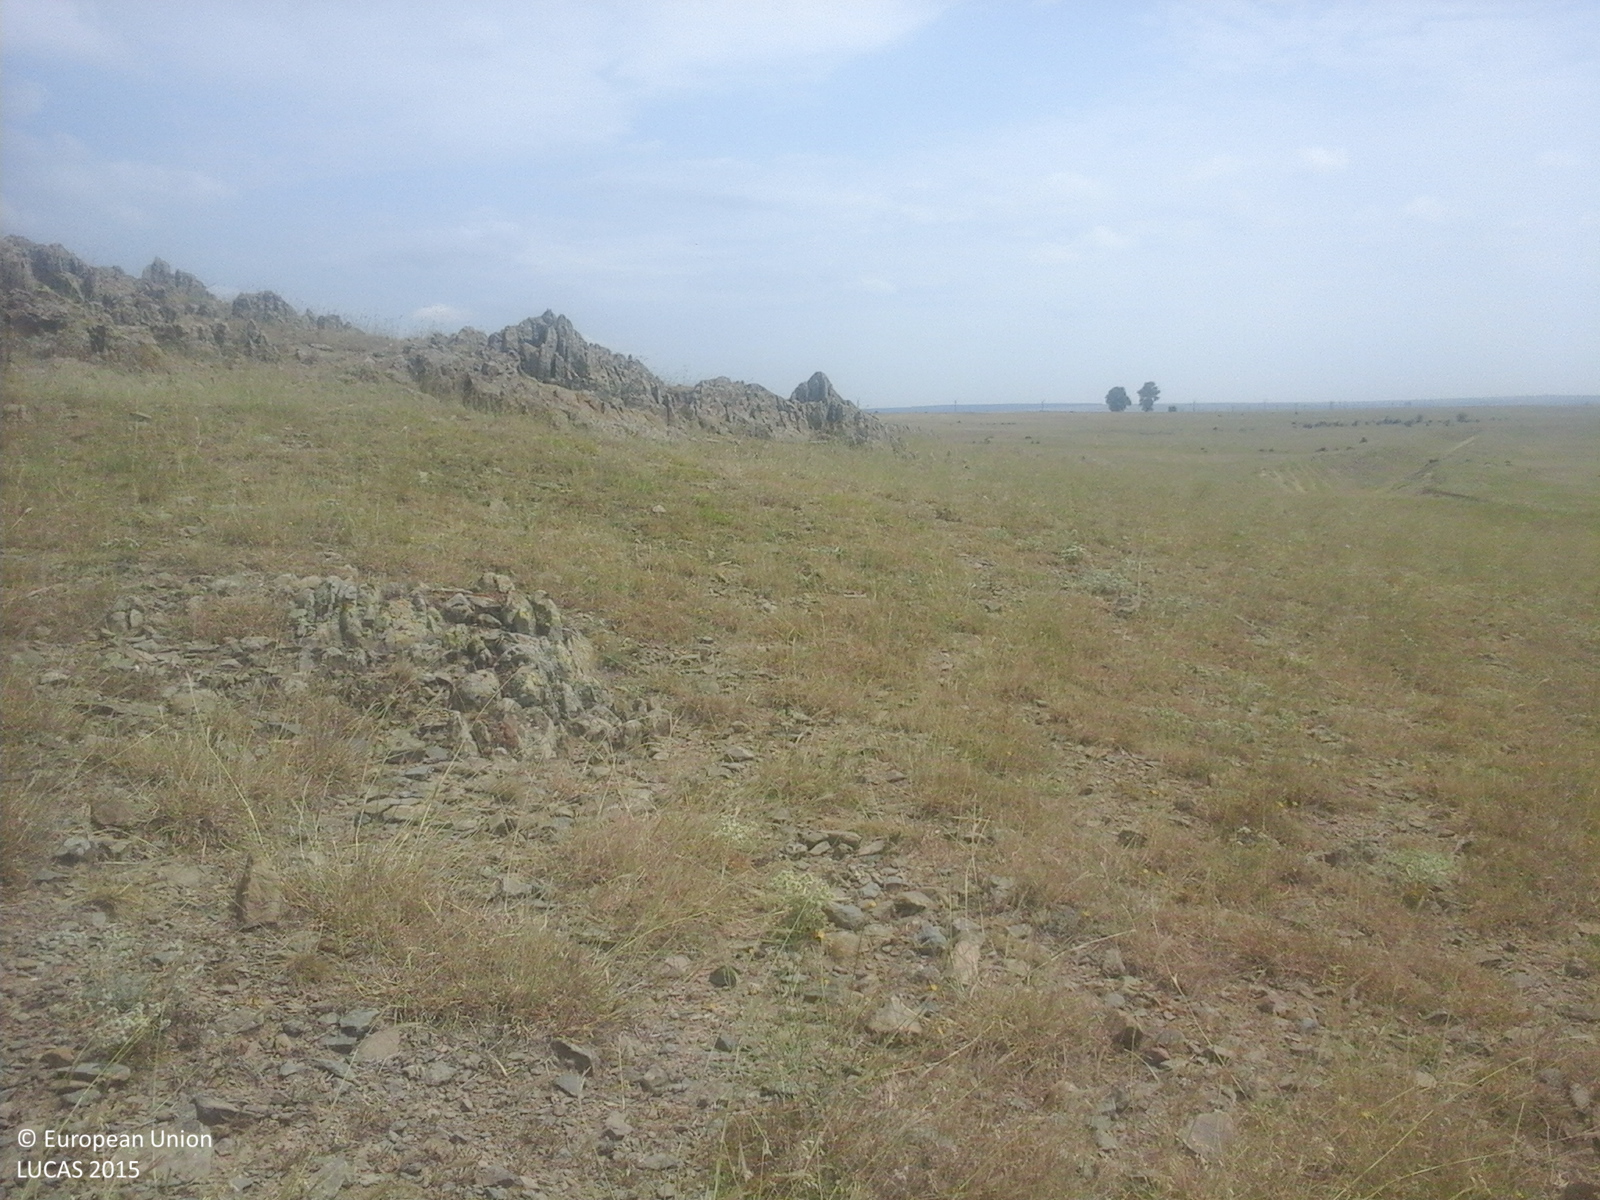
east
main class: Grassland
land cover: Grassland without tree/shrub cover
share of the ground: > 75 %
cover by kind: herbaceous plants 90 %, unconsolidated bare surface 10 %
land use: Agriculture (excluding fallow land and kitchen gardens)
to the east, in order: Grassland without tree/shrub cover
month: August
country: RO
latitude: 44.7508
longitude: 28.3221
